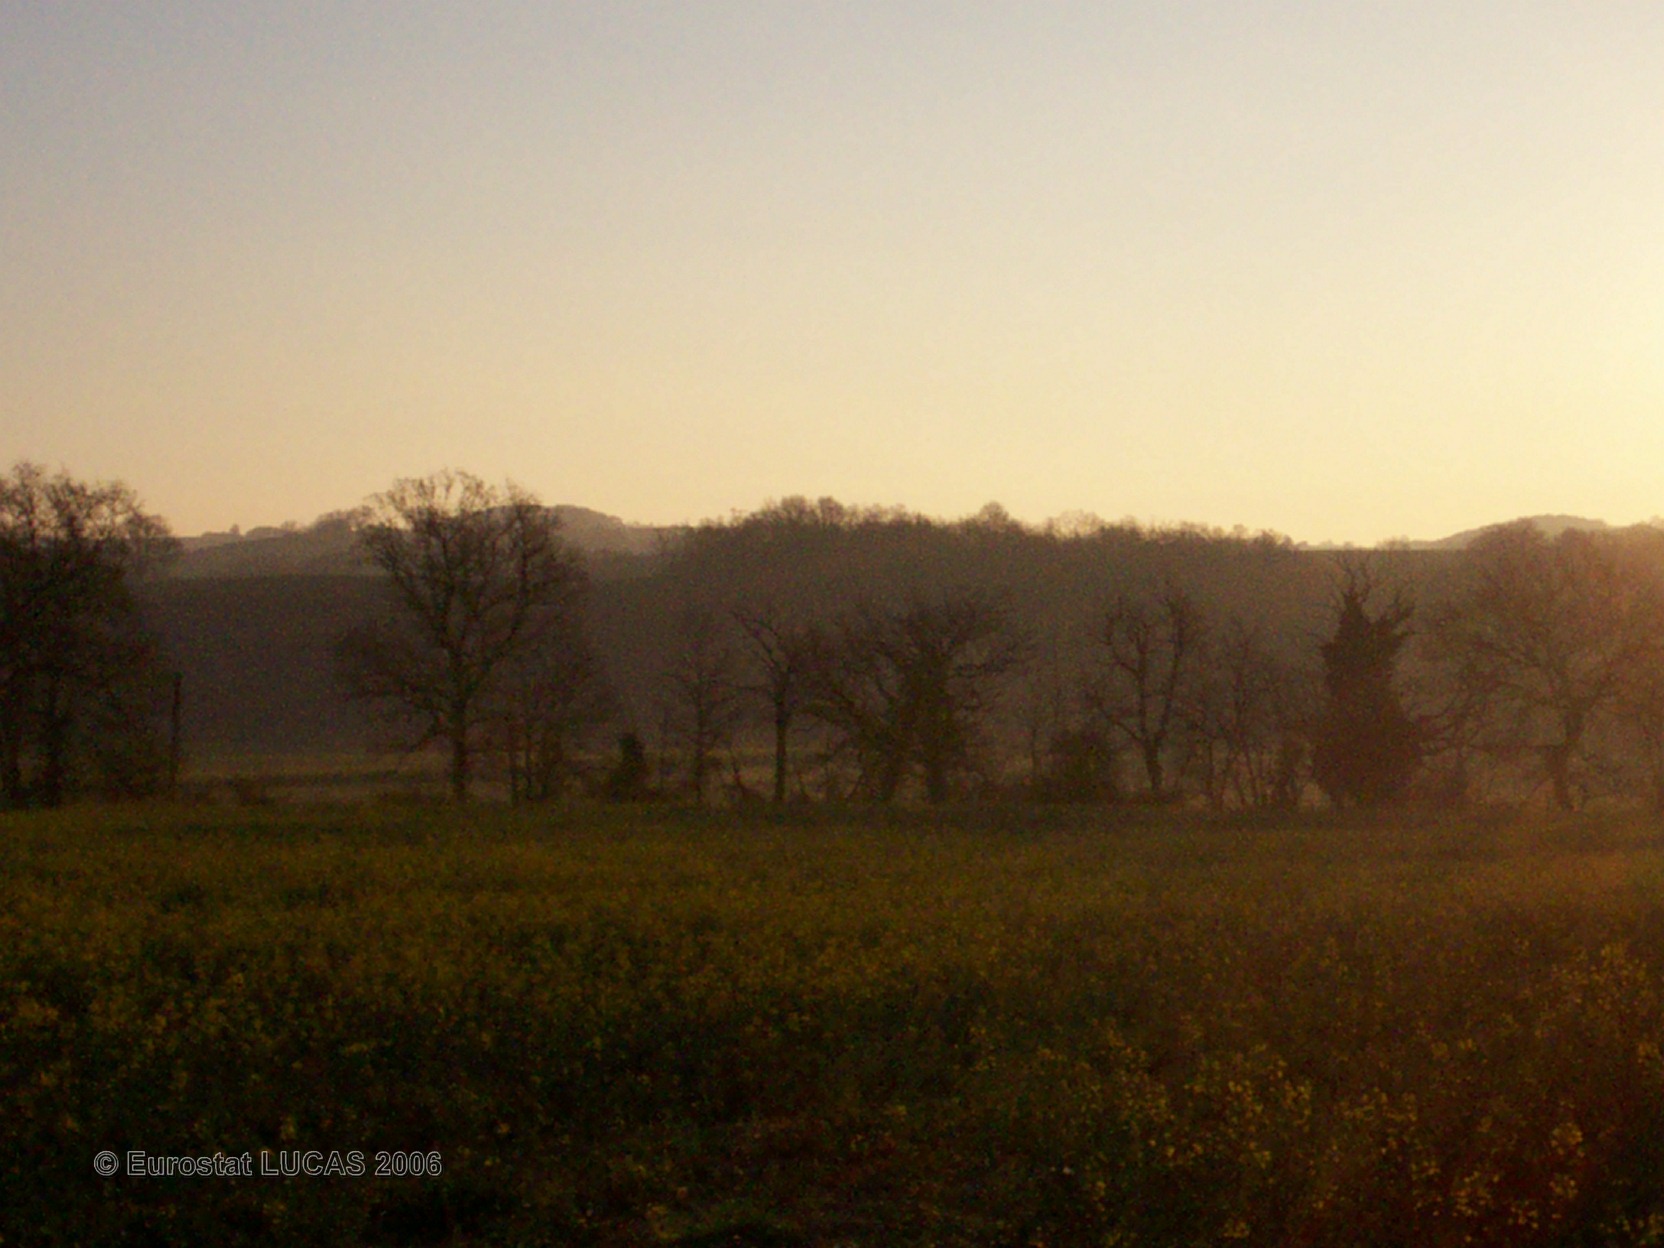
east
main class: Cropland
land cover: Rape and turnip rape
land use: Agriculture (excluding fallow land and kitchen gardens)
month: April
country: FR
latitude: 43.5078
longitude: 0.2371
